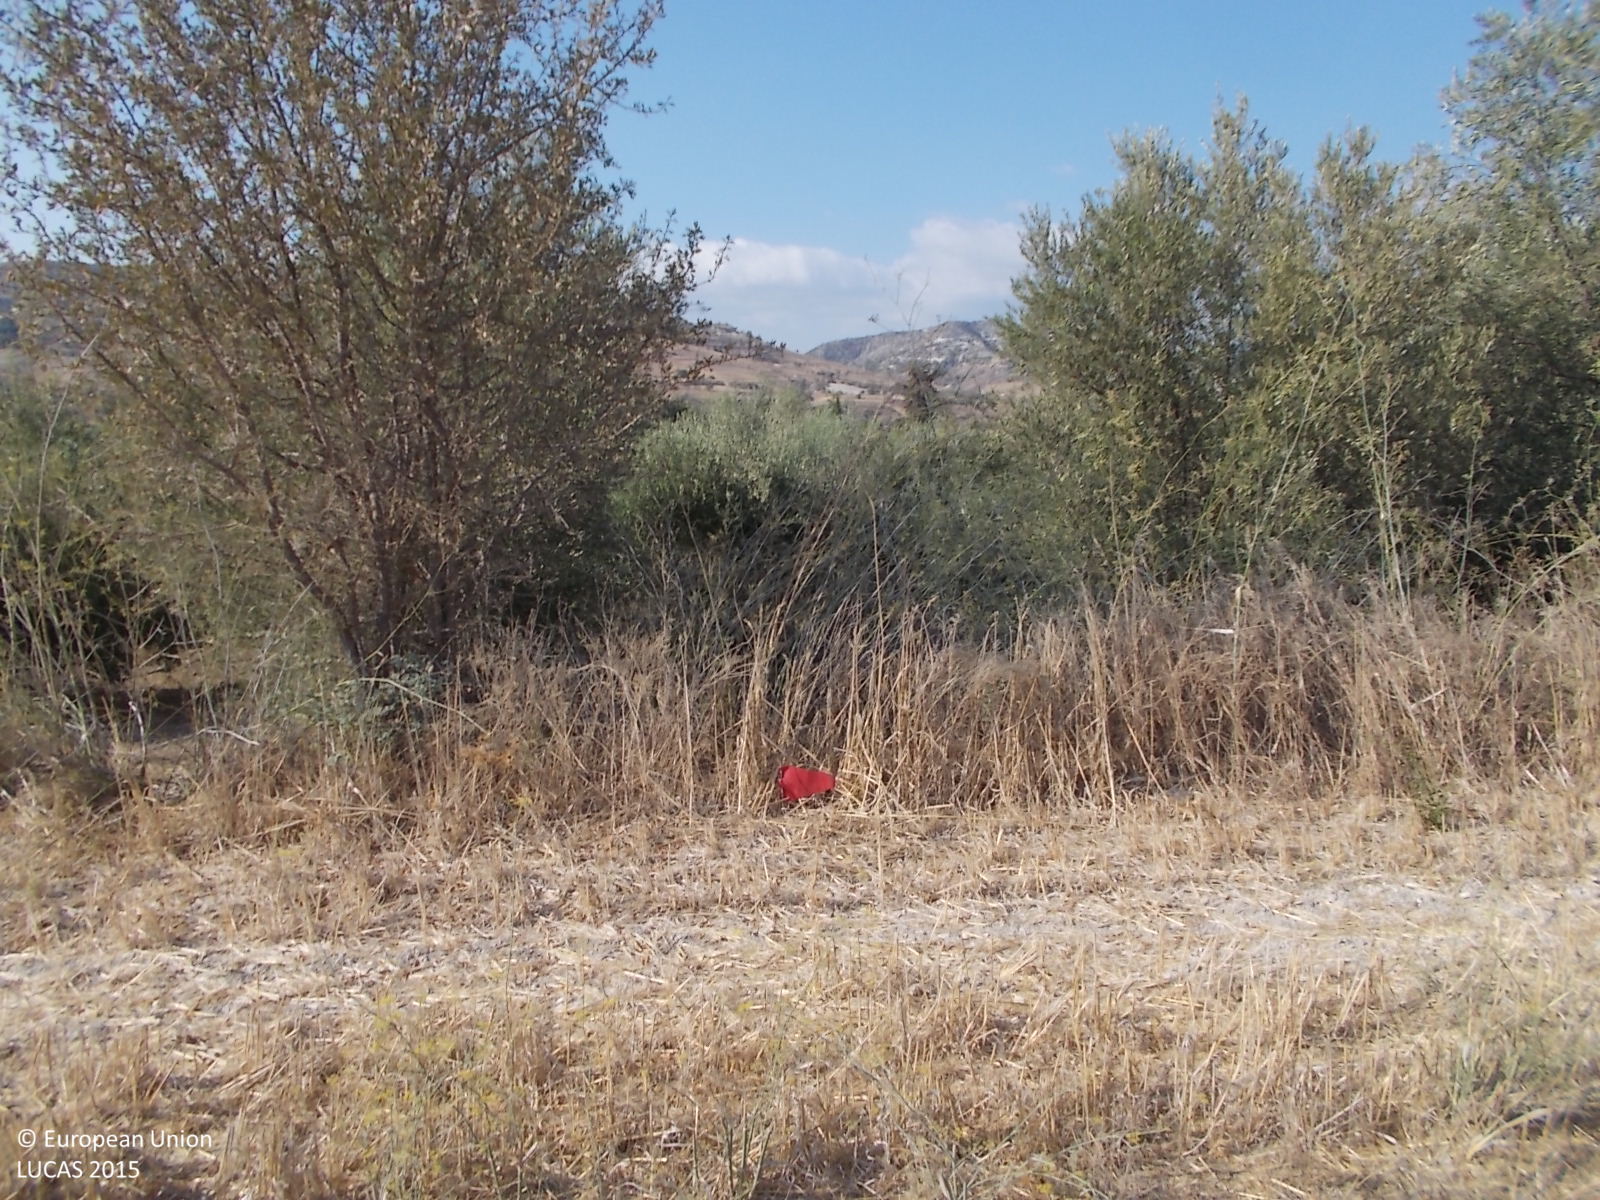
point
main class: Cropland
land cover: Olive groves
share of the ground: > 75 %
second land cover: Spontaneously vegetated surfaces
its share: 10 - 25 %
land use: Agriculture (excluding fallow land and kitchen gardens)
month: May
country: CY
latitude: 34.7688
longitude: 32.5816
